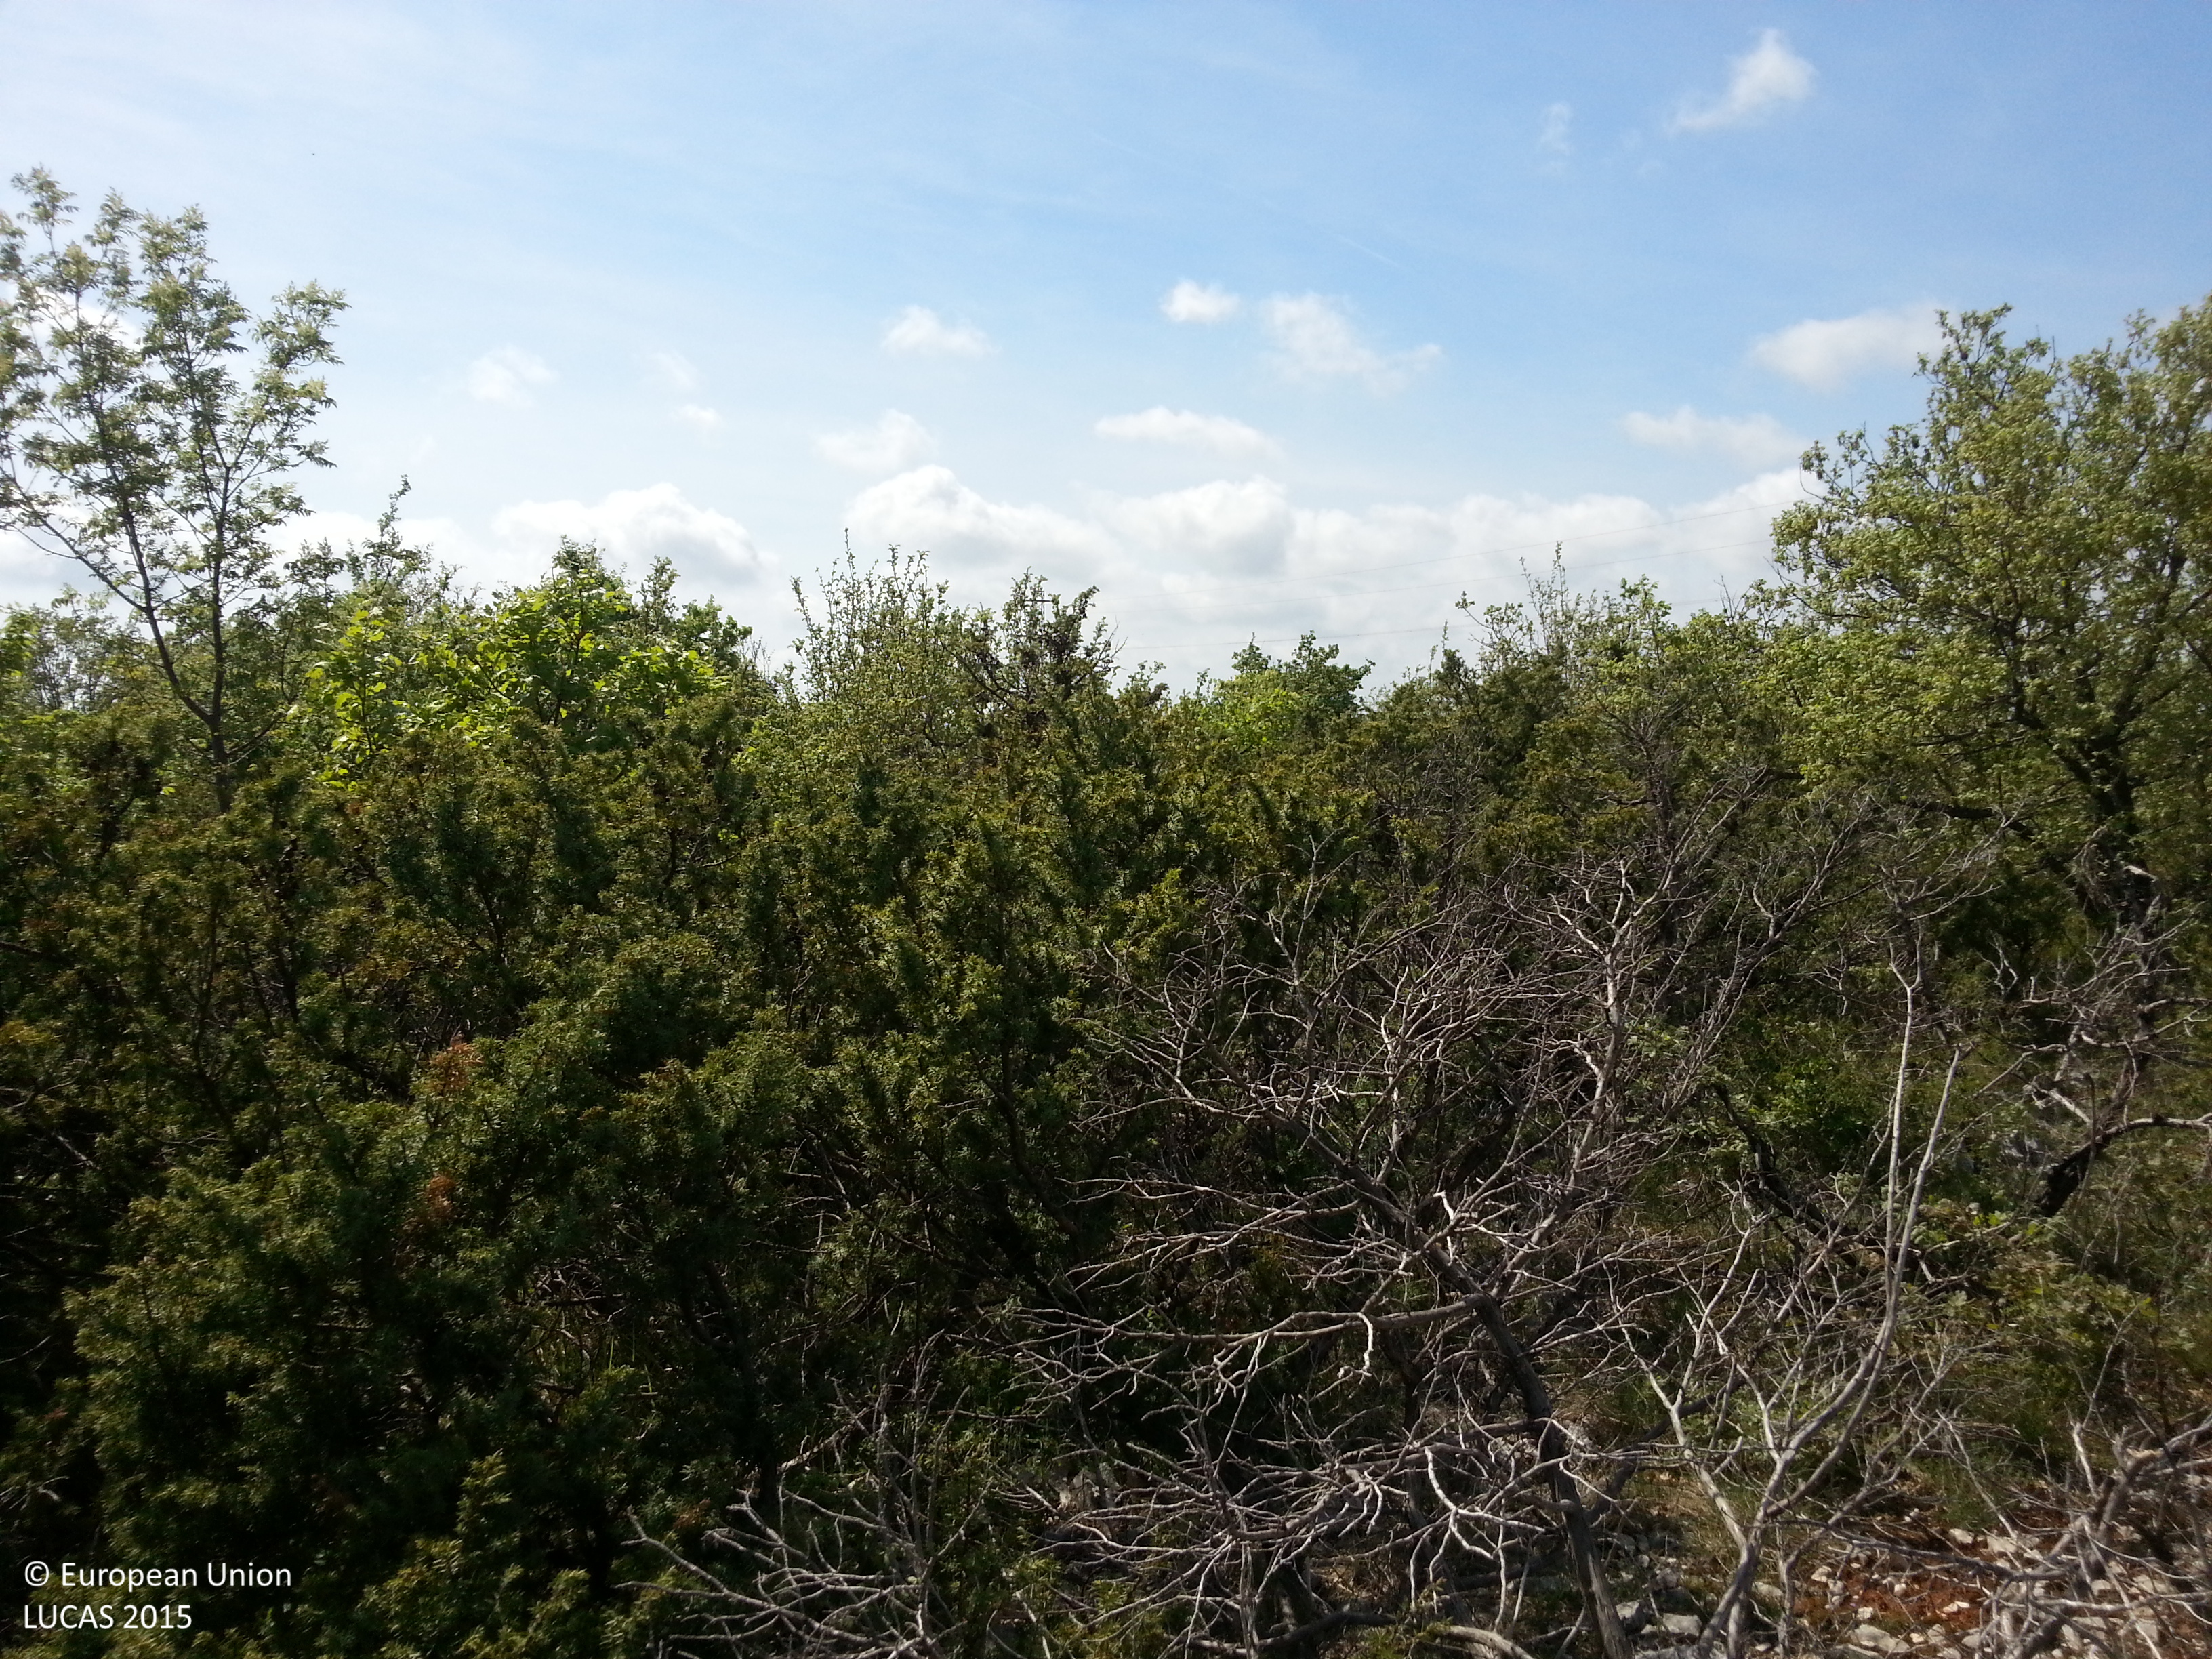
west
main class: Shrubland
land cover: Shrubland with sparse tree cover
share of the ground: > 75 %
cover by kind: shrubs 60 %, unconsolidated bare surface 20 %, herbaceous plants 15 %, coniferous forest trees 5 %
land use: Semi-natural and natural areas not in use
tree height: < 5 m
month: April
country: HR
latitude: 44.0203
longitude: 15.5682
